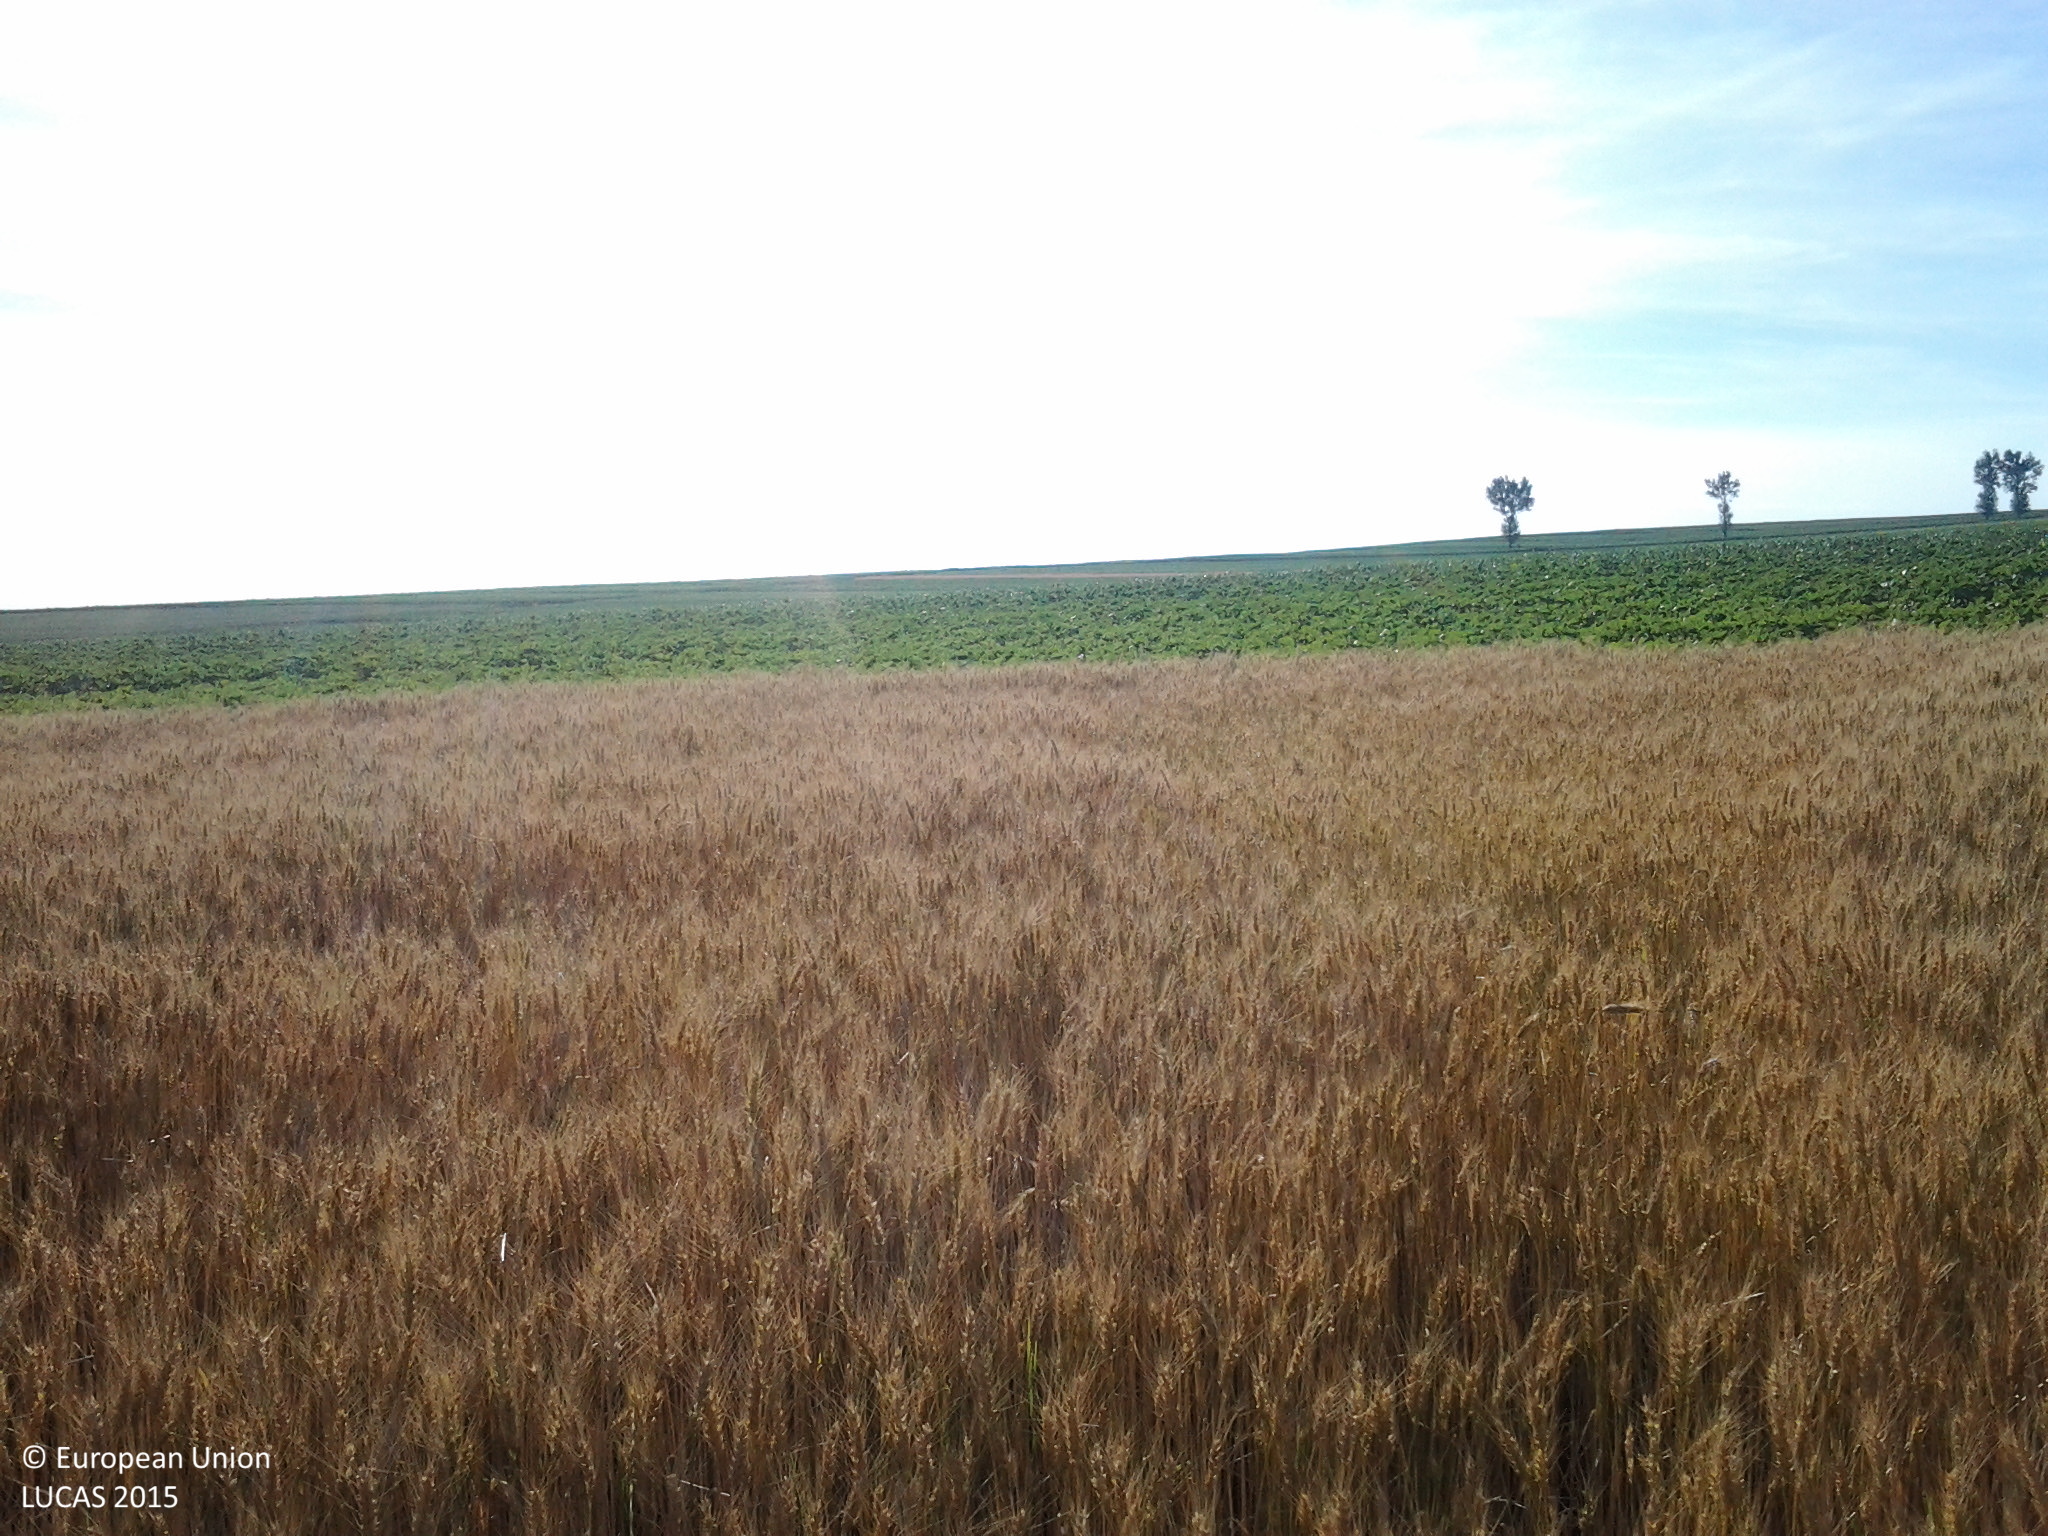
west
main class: Cropland
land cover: Durum wheat
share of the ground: > 75 %
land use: Agriculture (excluding fallow land and kitchen gardens)
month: June
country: RO
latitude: 47.1689
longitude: 26.8648
